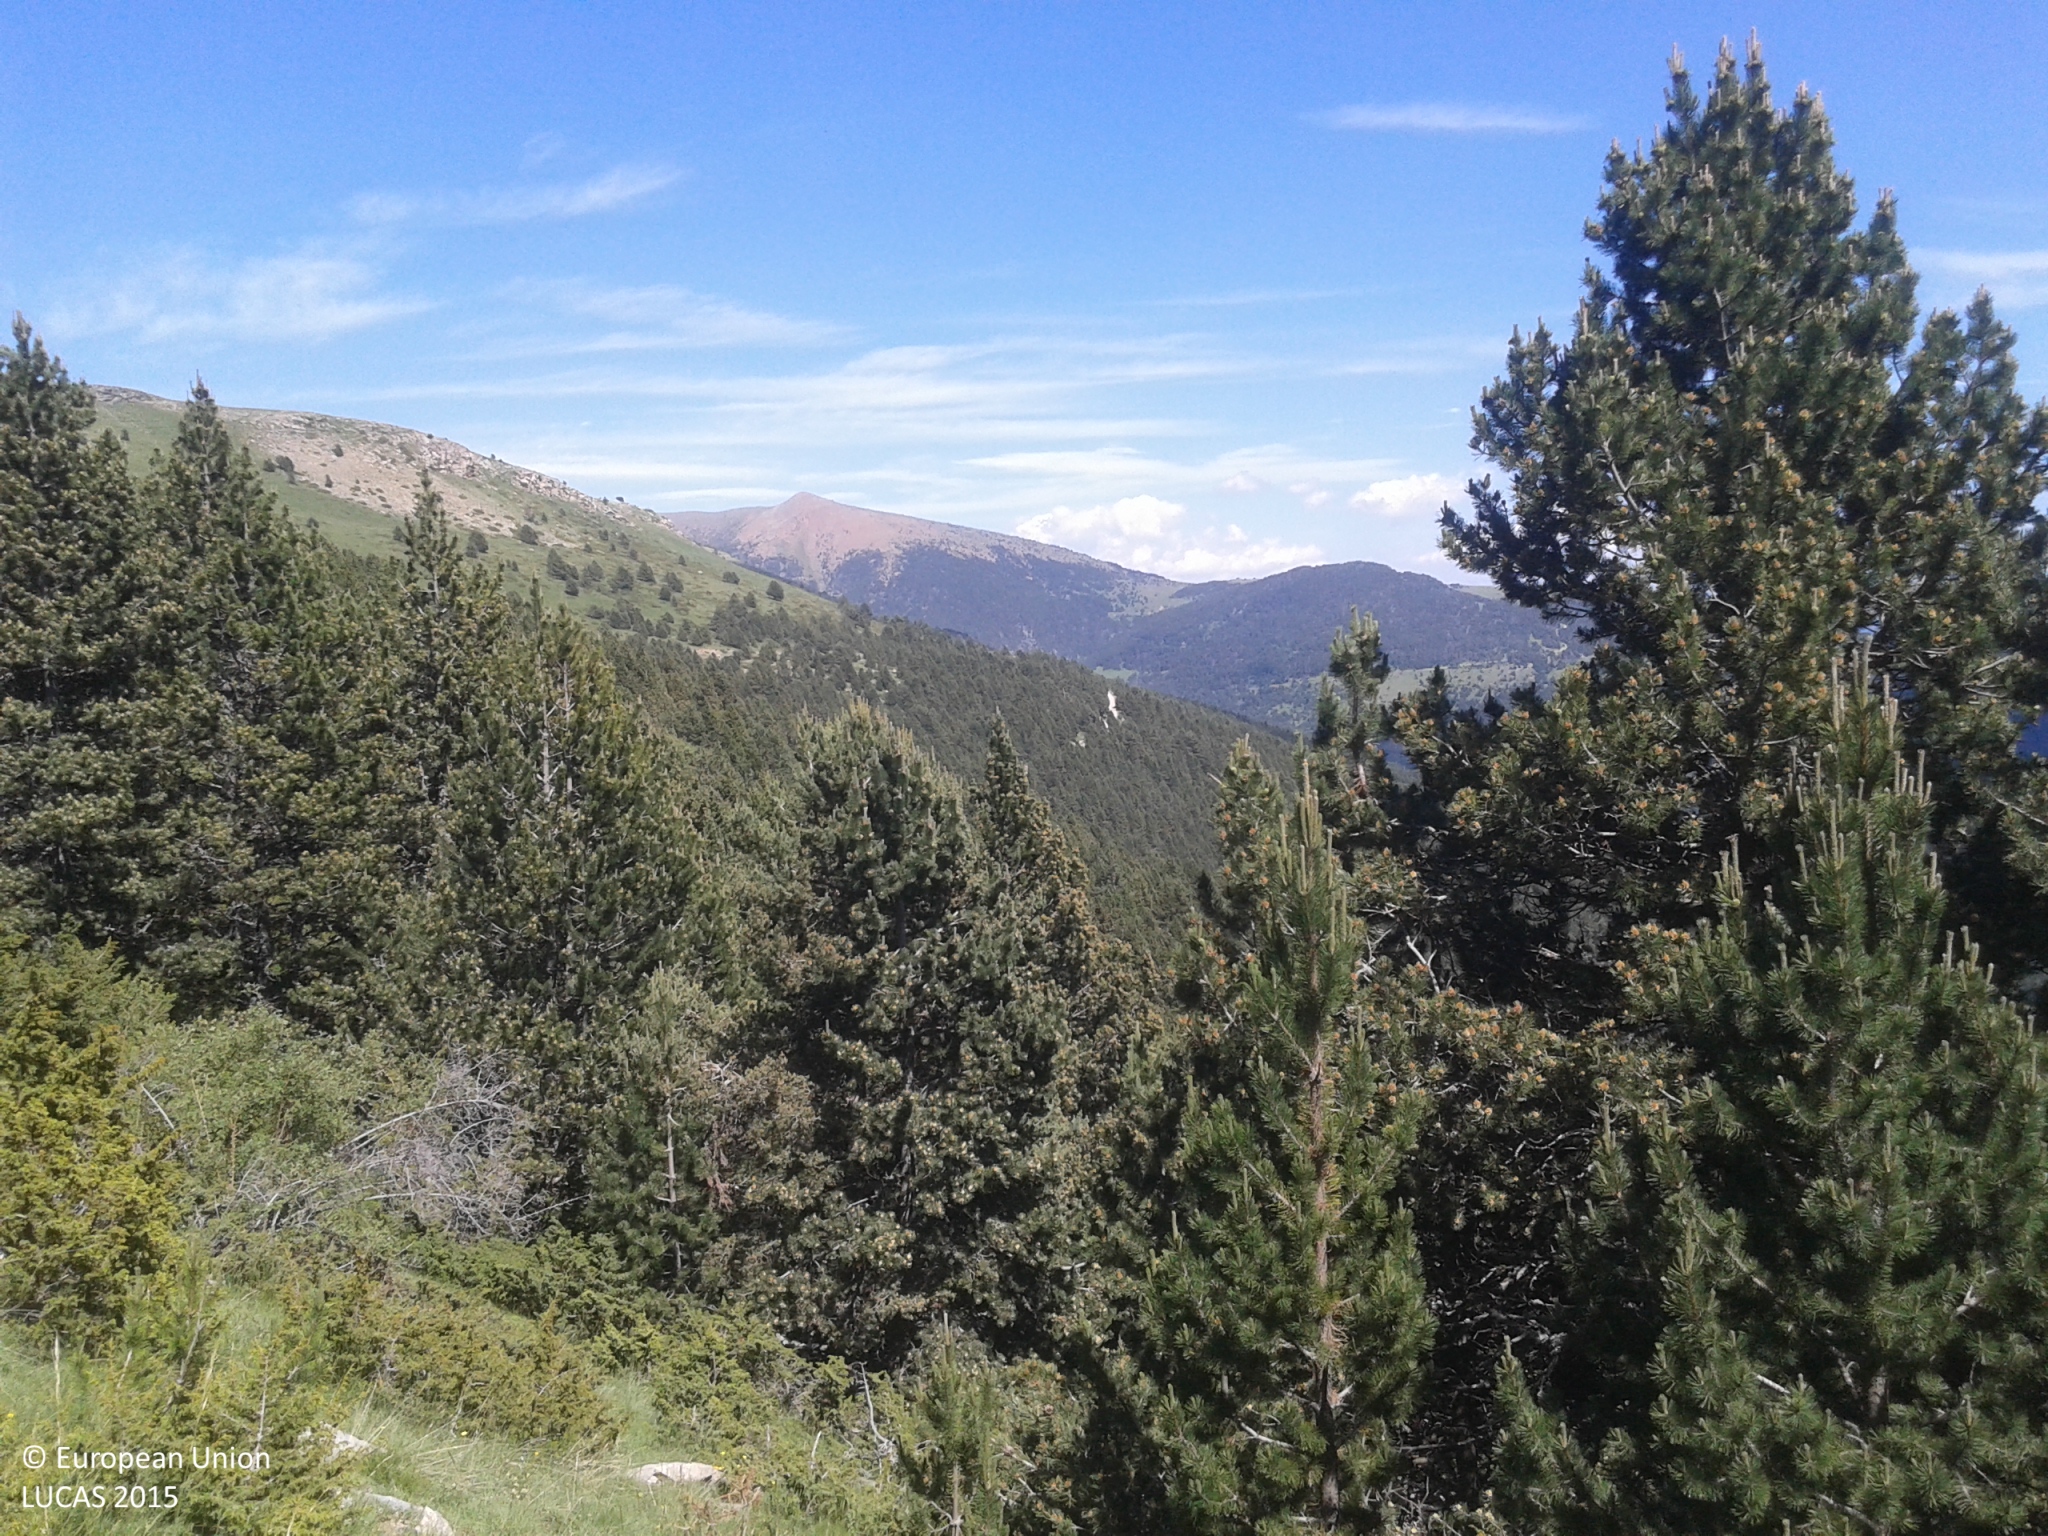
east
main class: Woodland
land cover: Pine dominated coniferous woodland
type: alpine coniferous forest
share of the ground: 25 - 50 %
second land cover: Grassland without tree/shrub cover
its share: 25 - 50 %
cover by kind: herbaceous plants 35 %, coniferous forest trees 30 %, shrubs 30 %, consolidated bare surface 5 %
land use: Agriculture (excluding fallow land and kitchen gardens)
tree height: > 5 m
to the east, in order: Pine dominated coniferous woodland; Grassland without tree/shrub cover
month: June
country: ES
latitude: 42.4265
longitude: 1.5383
